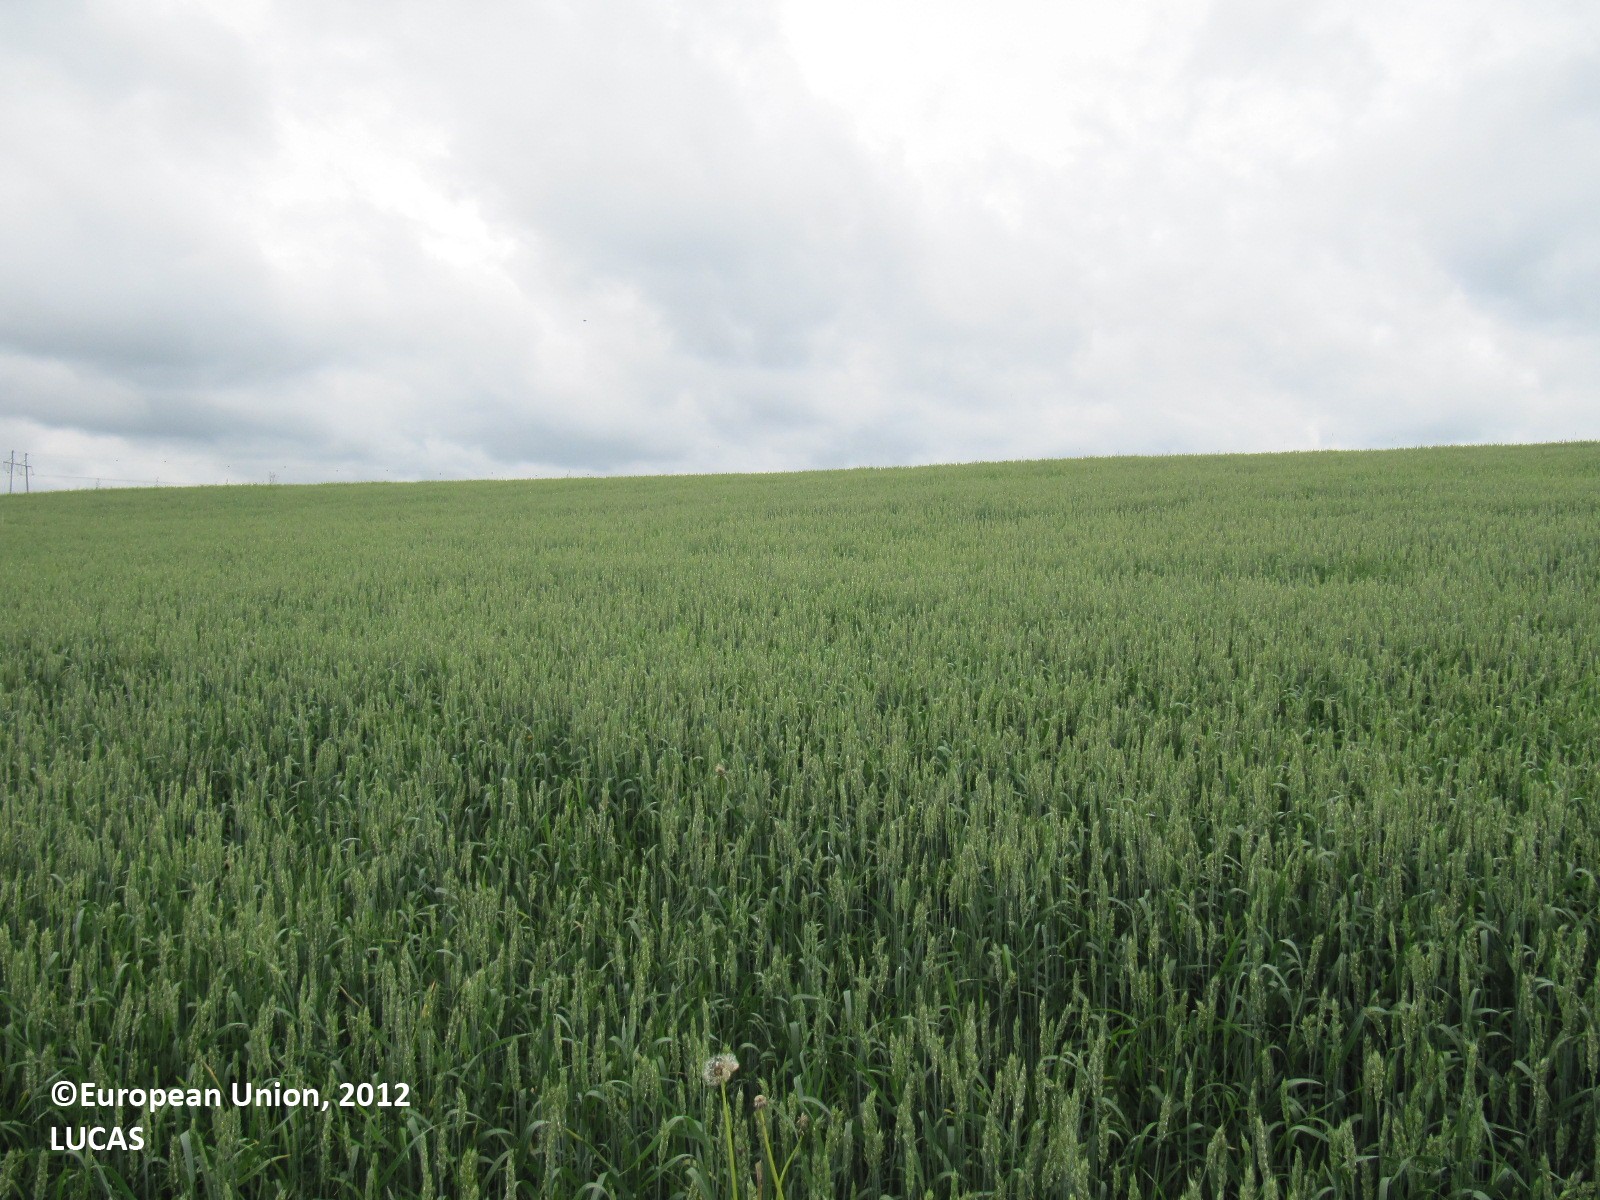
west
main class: Cropland
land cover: Common wheat
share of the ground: > 75 %
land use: Agriculture (excluding fallow land and kitchen gardens)
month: July
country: FI
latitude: 60.4524
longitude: 23.9663
